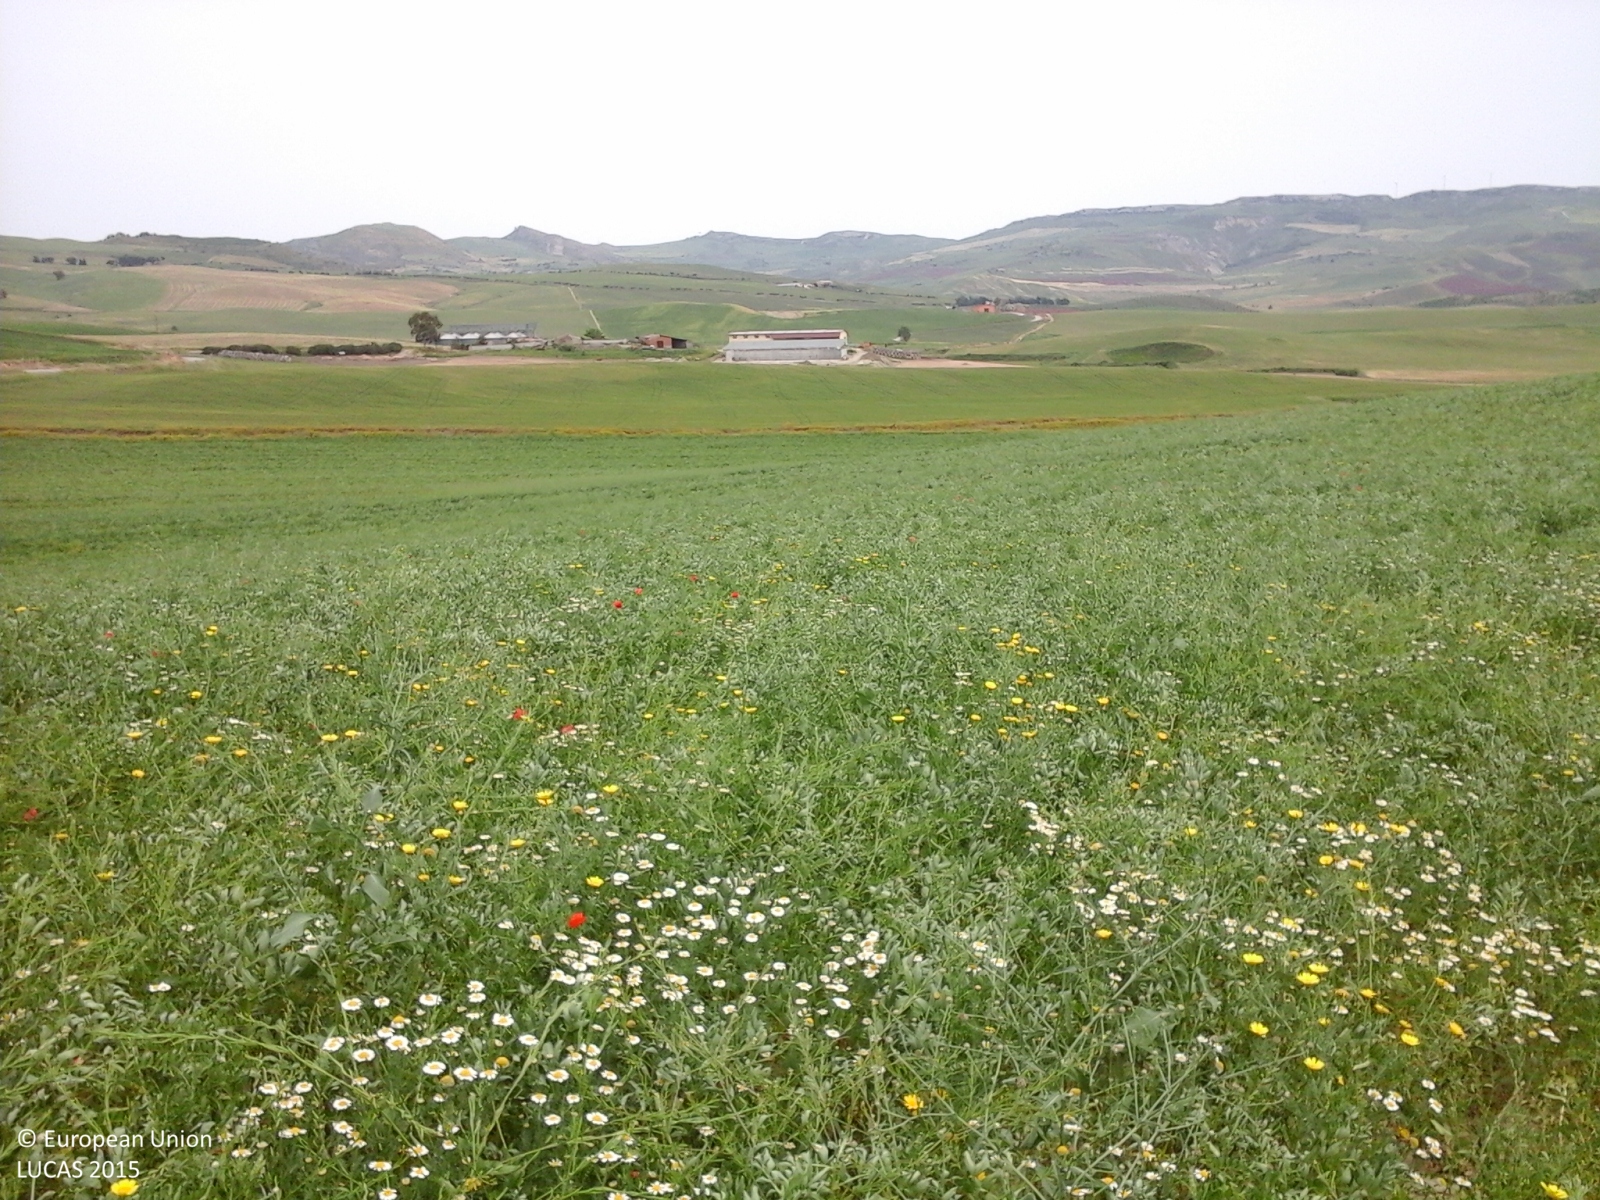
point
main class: Cropland
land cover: Dry pulses
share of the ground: > 75 %
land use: Agriculture (excluding fallow land and kitchen gardens)
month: May
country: IT
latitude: 37.6664
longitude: 13.9277
